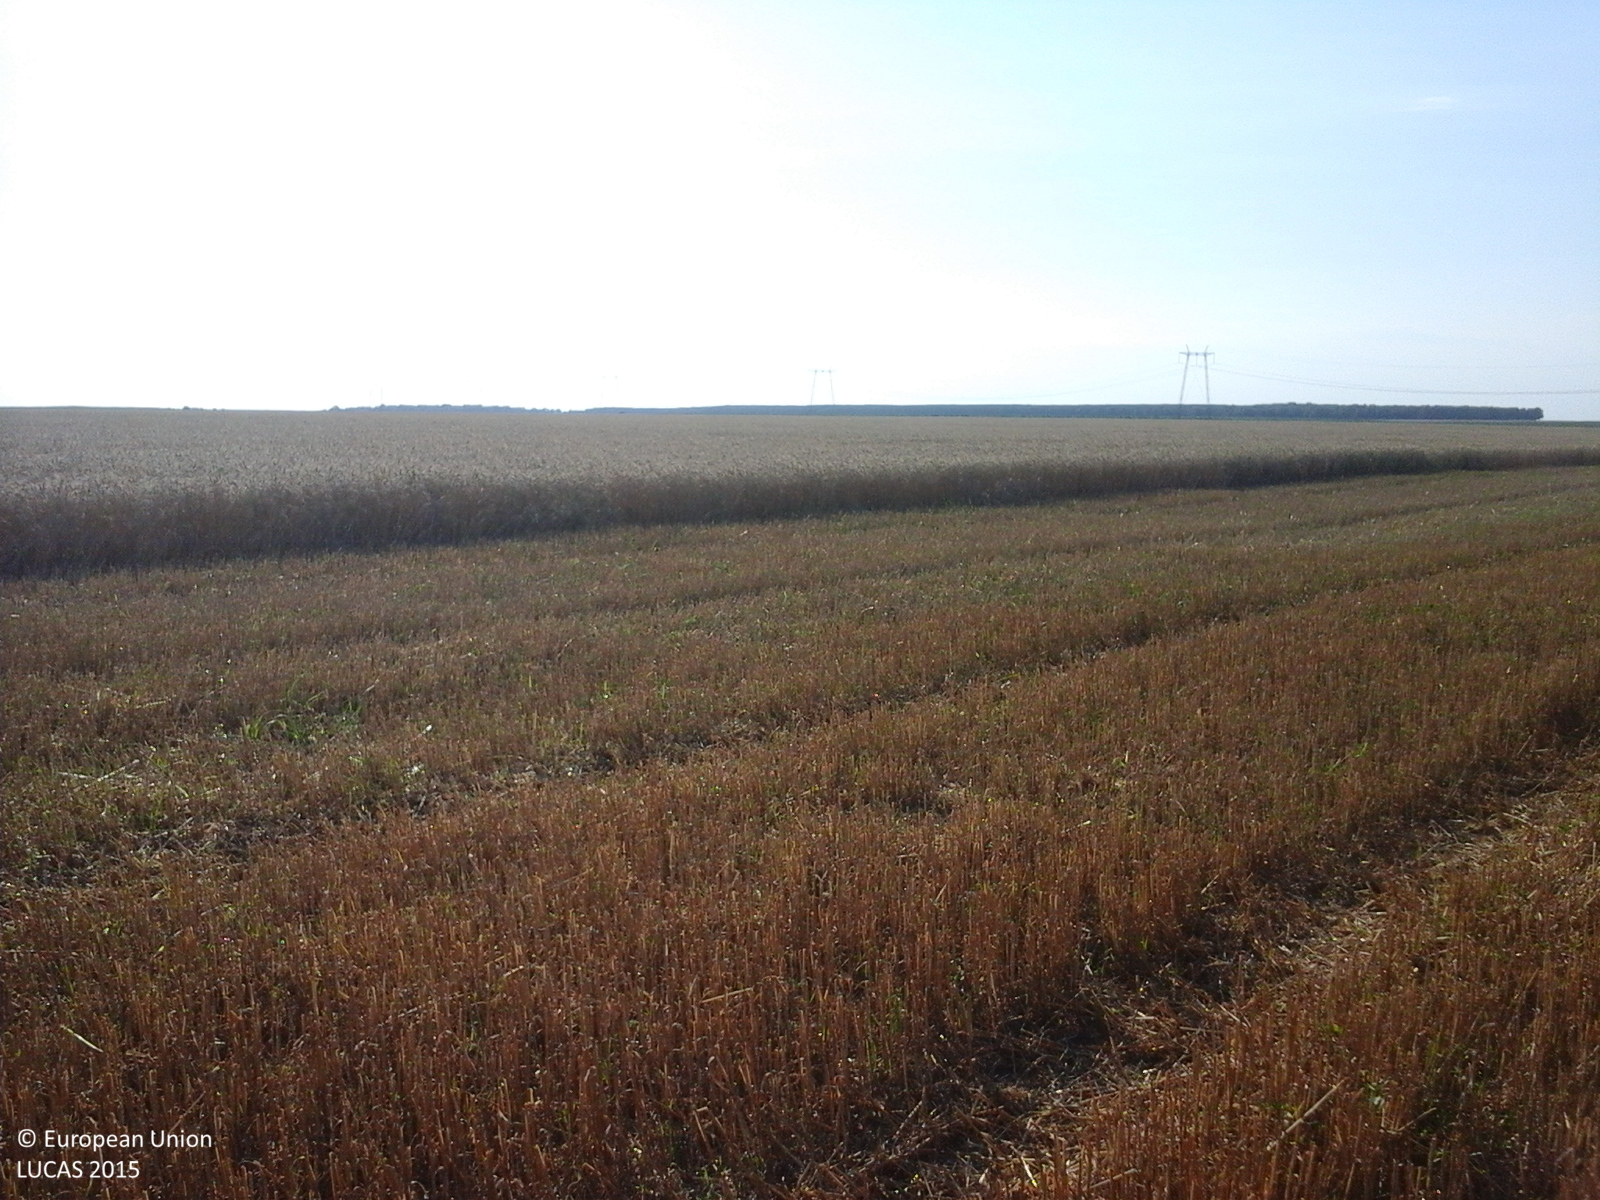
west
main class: Cropland
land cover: Common wheat
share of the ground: > 75 %
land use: Agriculture (excluding fallow land and kitchen gardens)
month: July
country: RO
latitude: 44.3107
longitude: 24.6522
